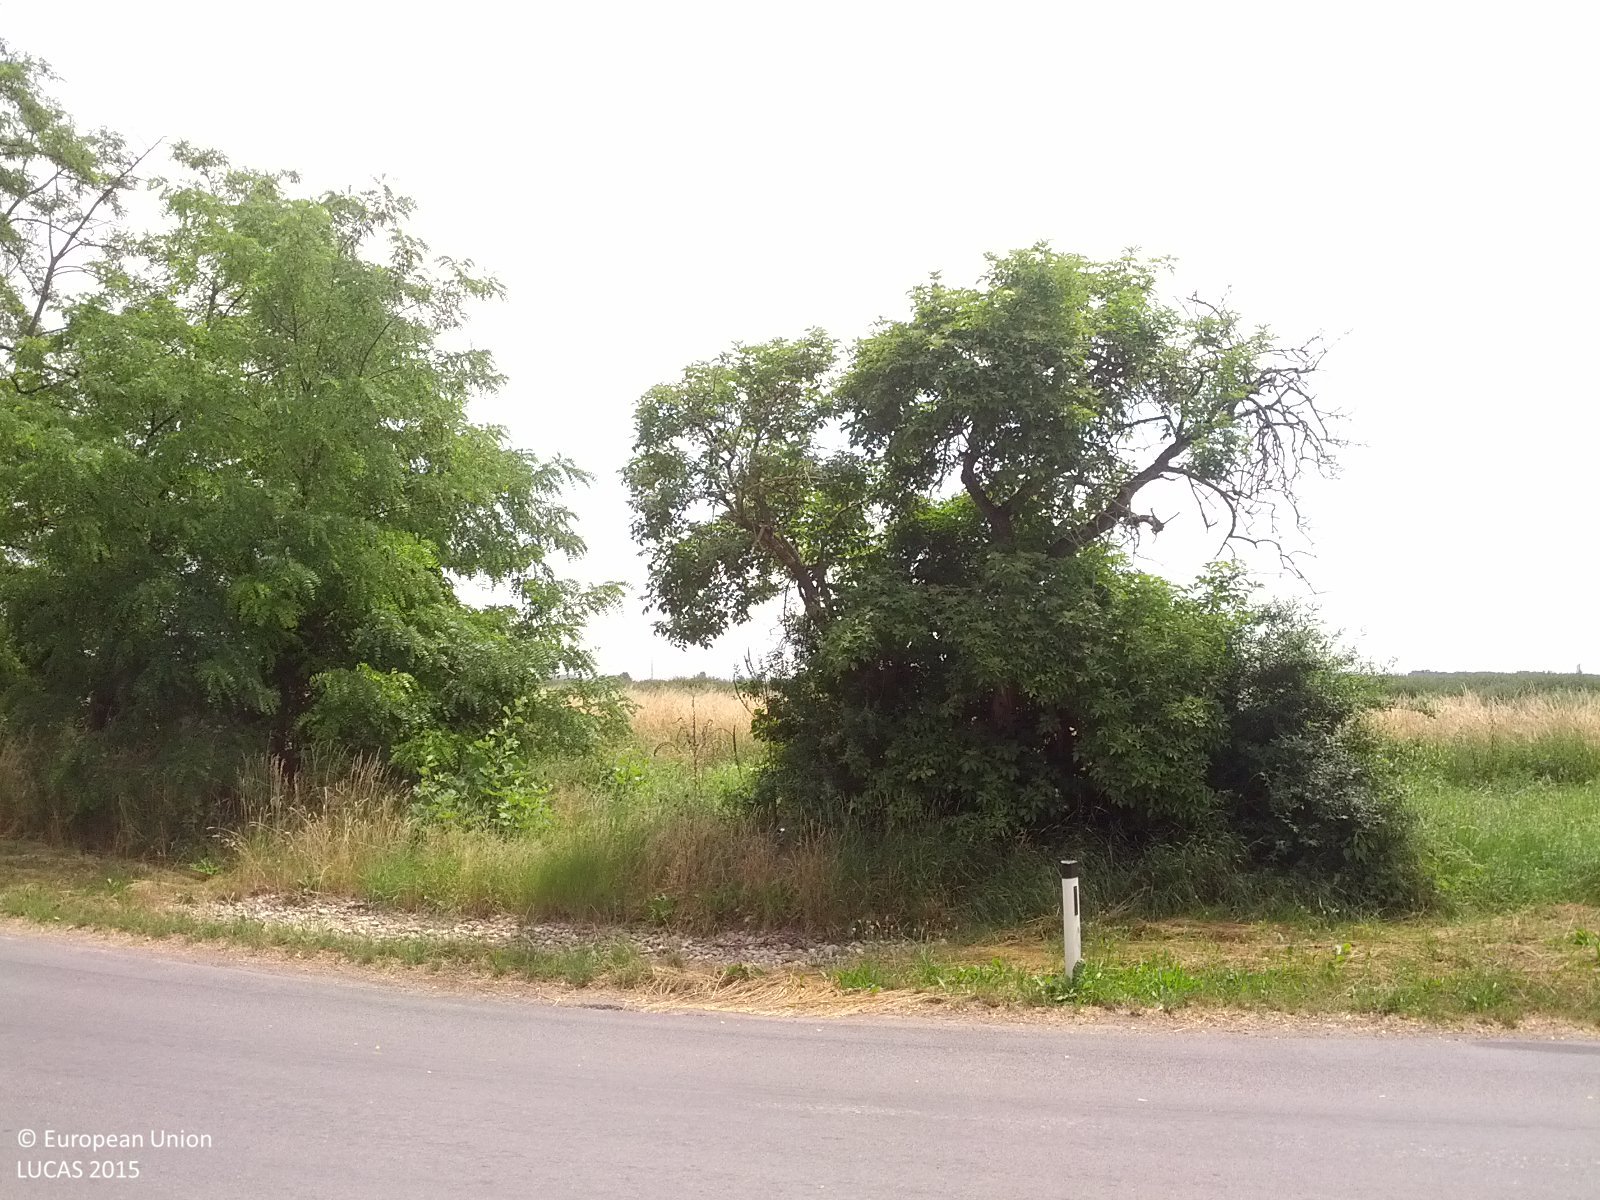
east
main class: Woodland
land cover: Broadleaved woodland
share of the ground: 25 - 50 %
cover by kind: herbaceous plants 60 %, broadleaved forest trees 35 %, shrubs 5 %
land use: Amenities, museums, leisure
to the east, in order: Broadleaved woodland; Grassland without tree/shrub cover; Fences; Grass margins; Paved roads, cycling and walking lanes; Grass margins; Abandoned hedges; Grassland without tree/shrub cover; Durum wheat
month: June
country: AT
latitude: 48.1908
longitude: 16.5569
